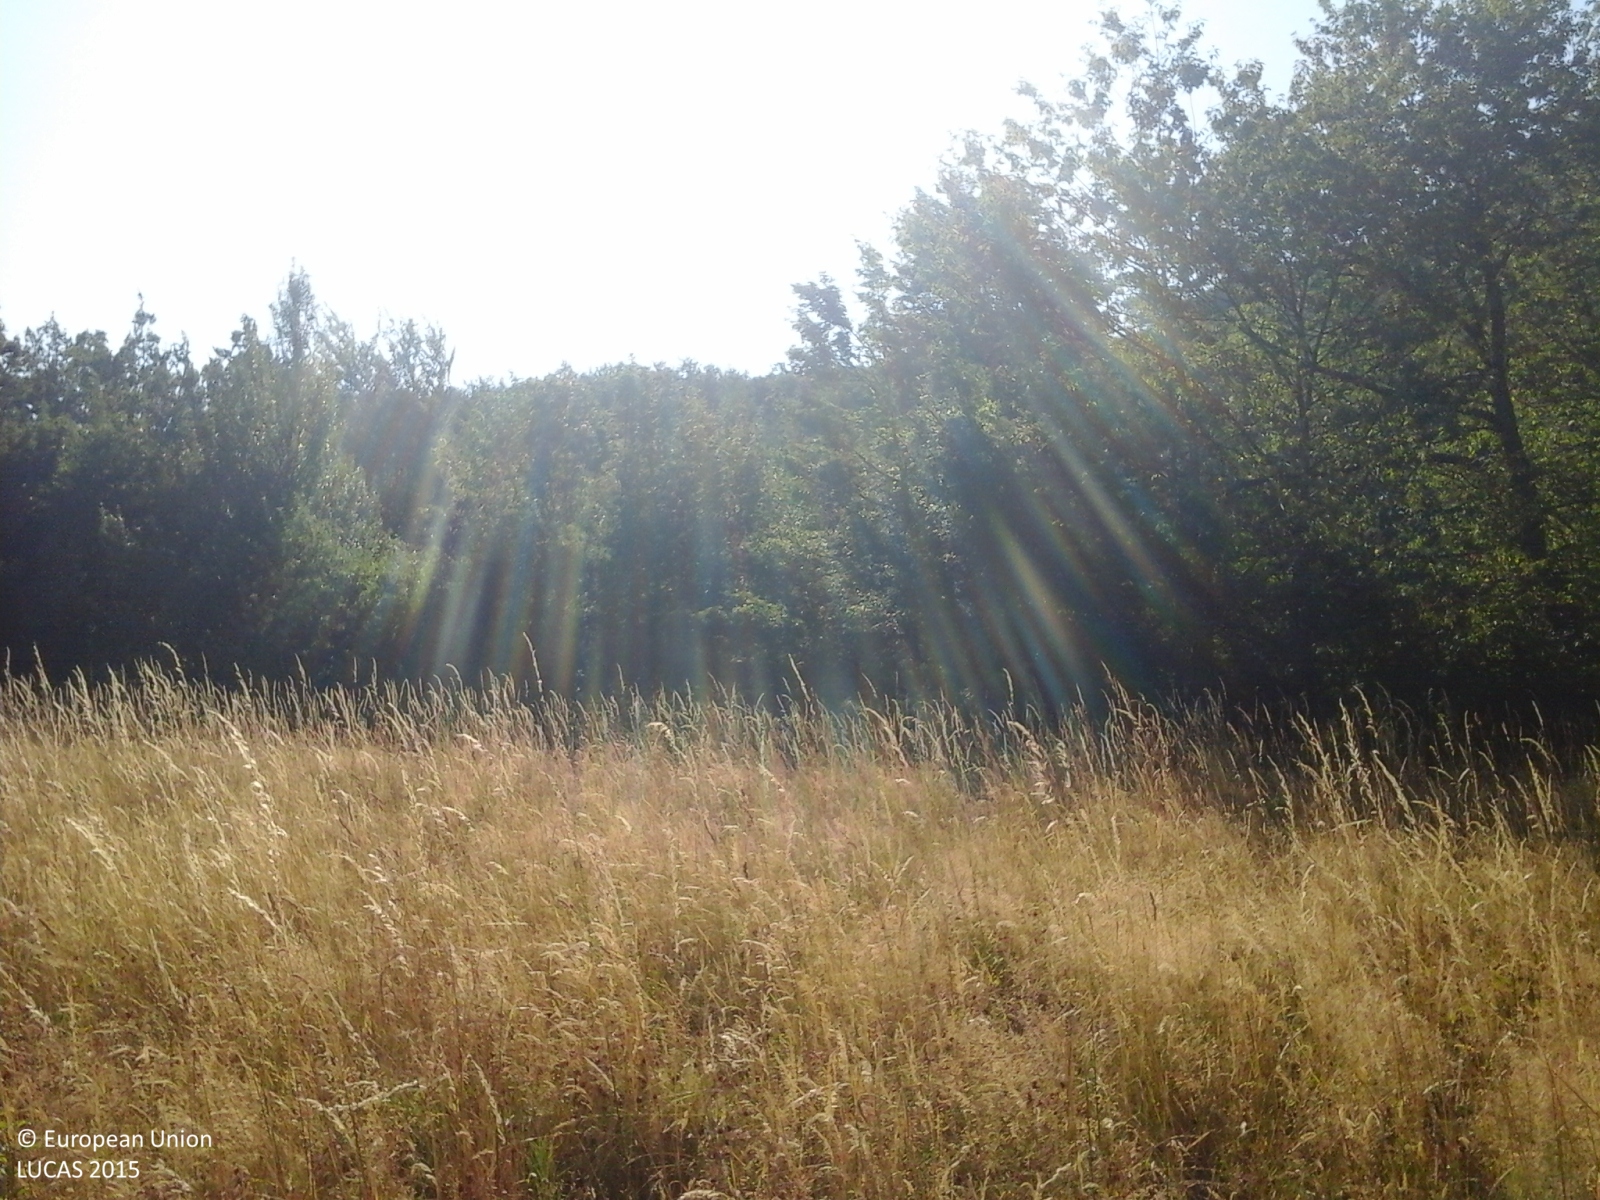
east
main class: Woodland
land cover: Broadleaved woodland
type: mountainous beech forest
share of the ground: > 75 %
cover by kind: broadleaved forest trees 100 %
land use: Forestry
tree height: > 5 m
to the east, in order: Broadleaved woodland
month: July
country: IT
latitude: 44.2587
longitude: 10.5873
